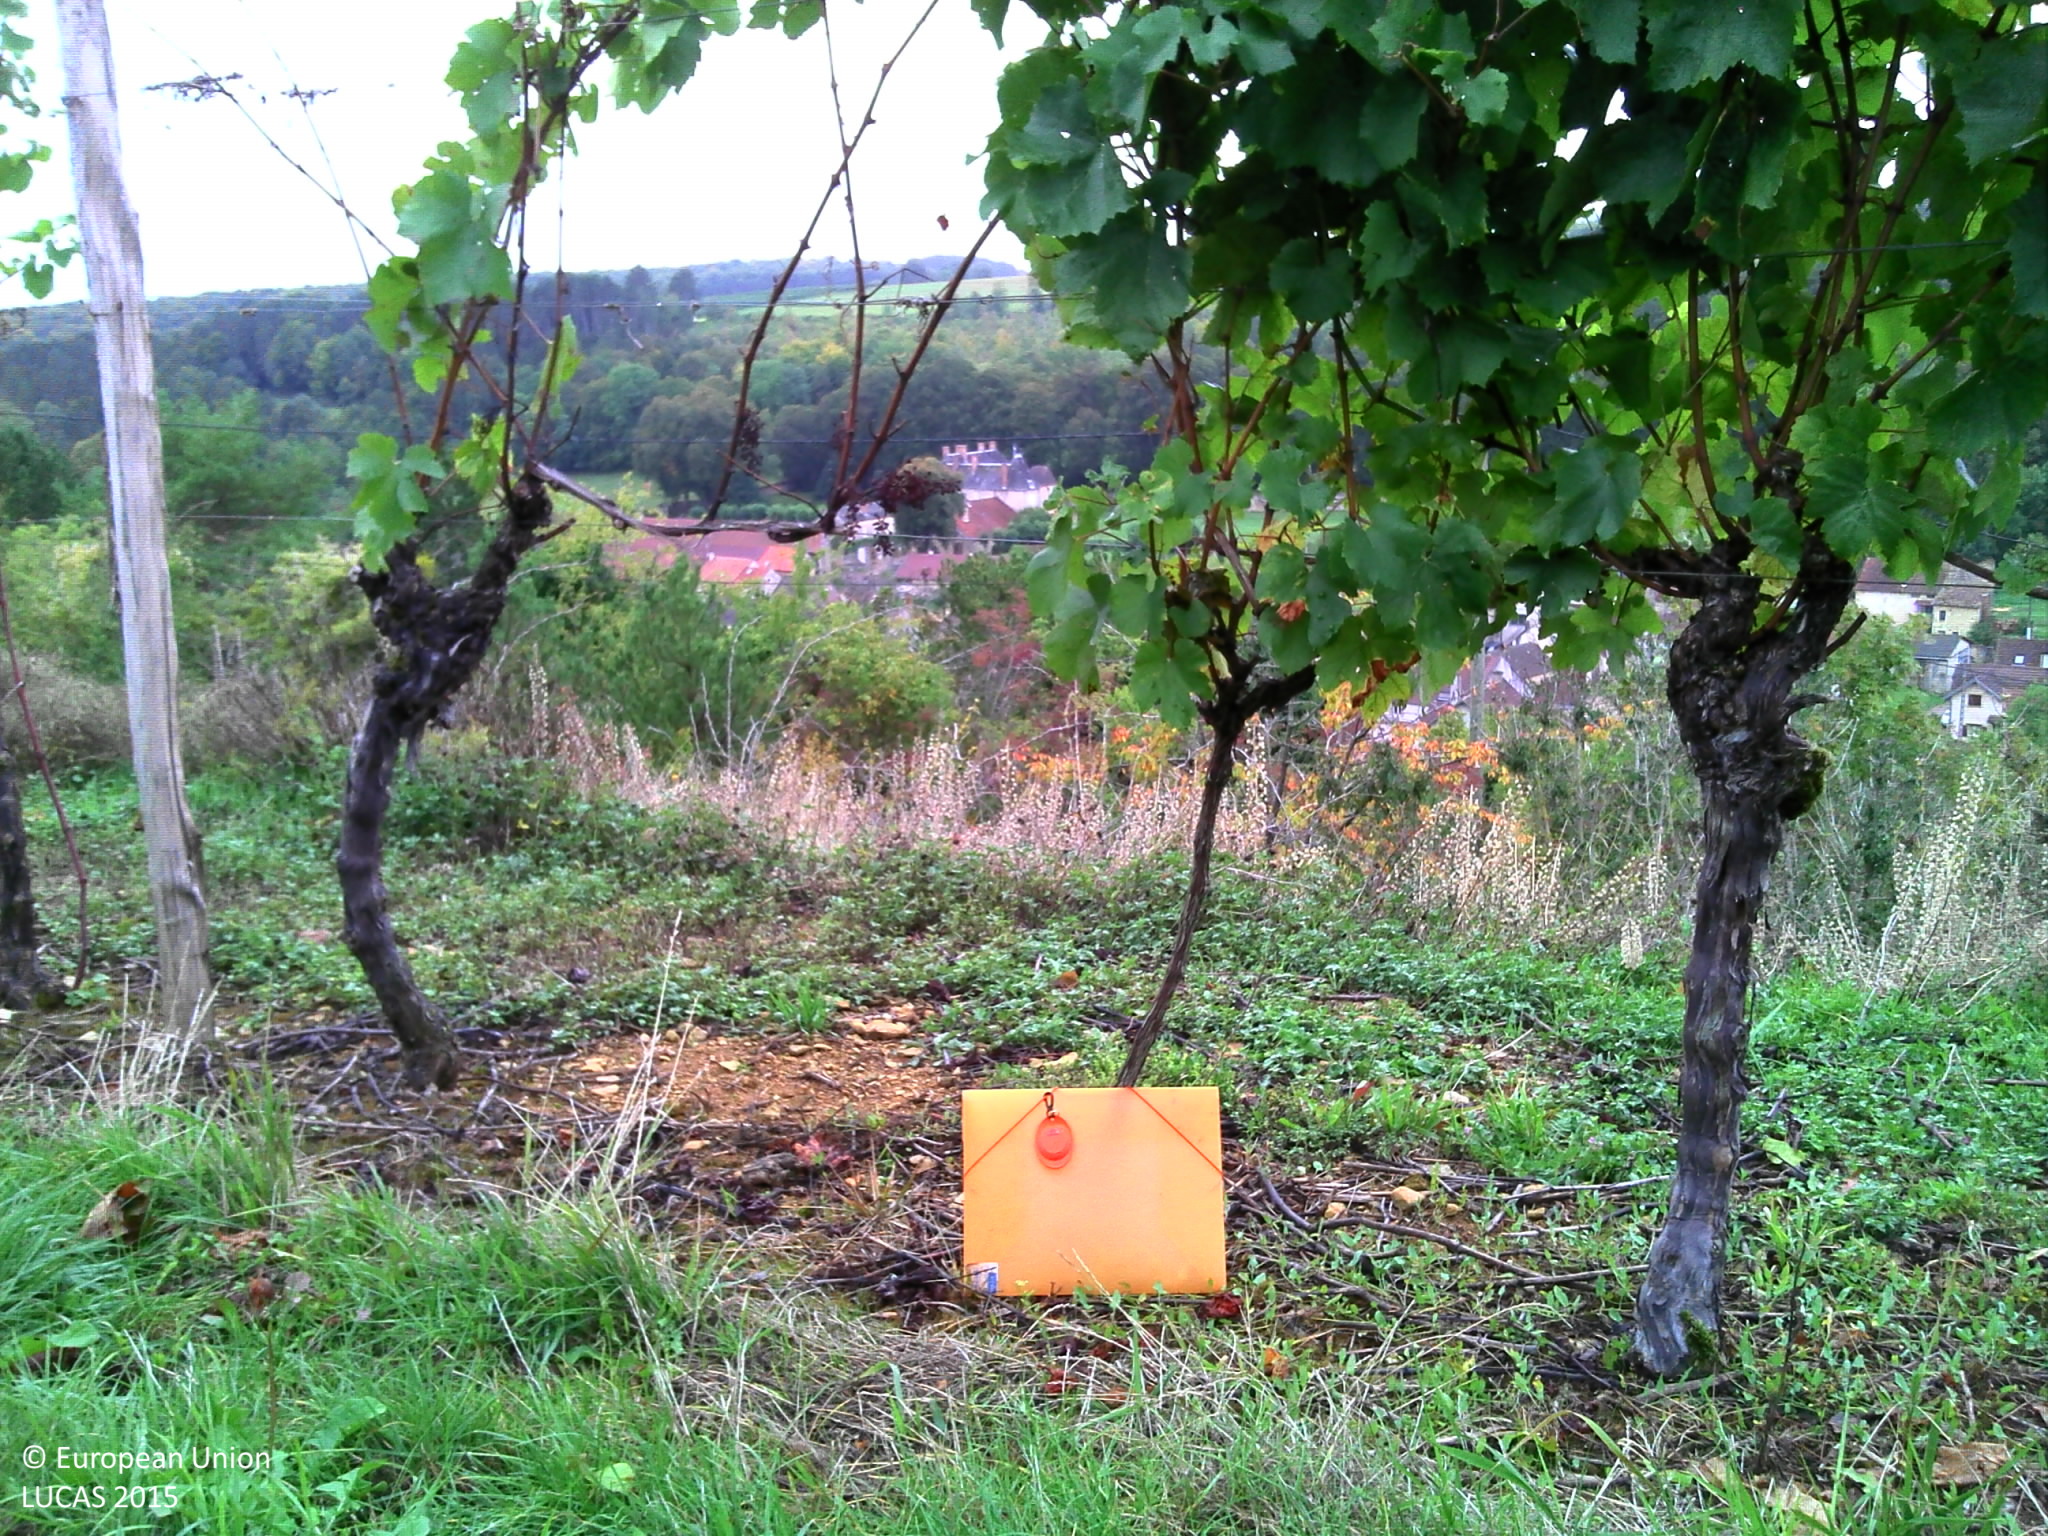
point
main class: Cropland
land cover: Vineyards
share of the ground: 10 - 25 %
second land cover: Grassland without tree/shrub cover
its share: > 75 %
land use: Agriculture (excluding fallow land and kitchen gardens)
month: September
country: FR
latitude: 47.1112
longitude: 4.8478
